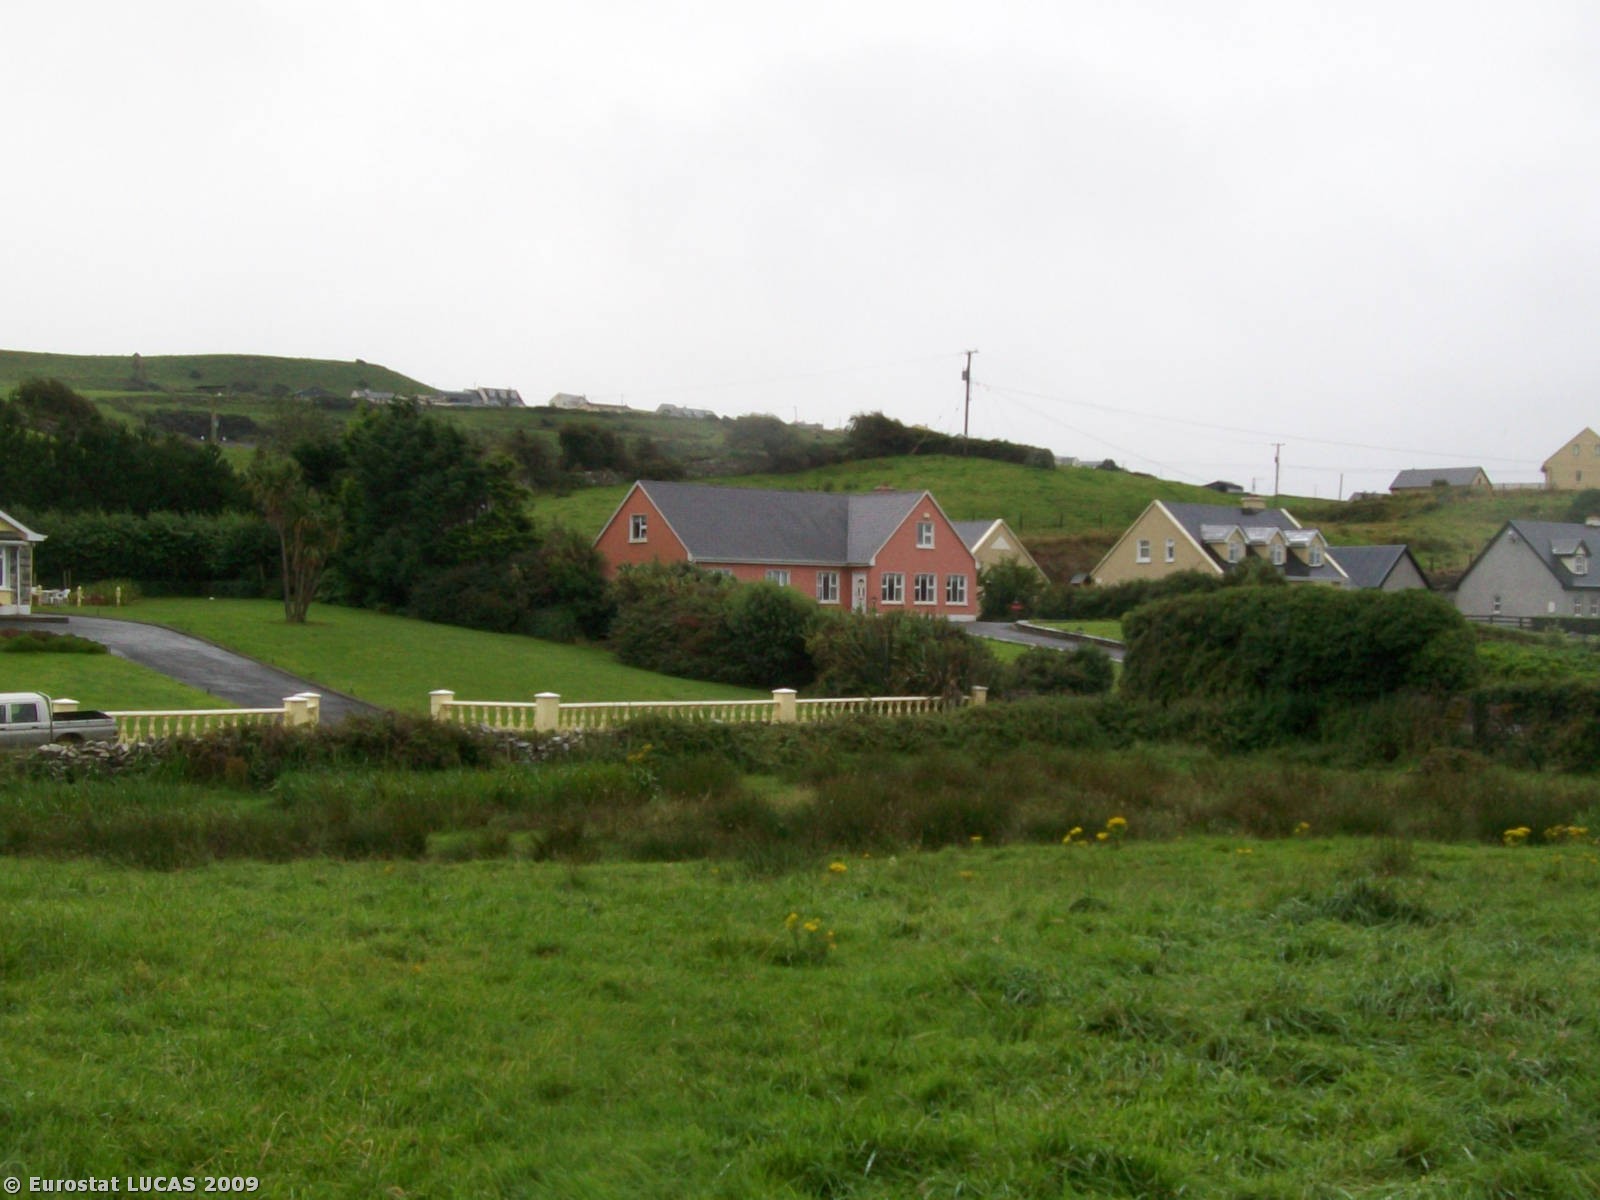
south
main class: Grassland
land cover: Grassland without tree/shrub cover
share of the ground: > 75 %
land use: Agriculture (excluding fallow land and kitchen gardens)
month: August
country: IE
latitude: 52.9357
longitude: -9.3145
